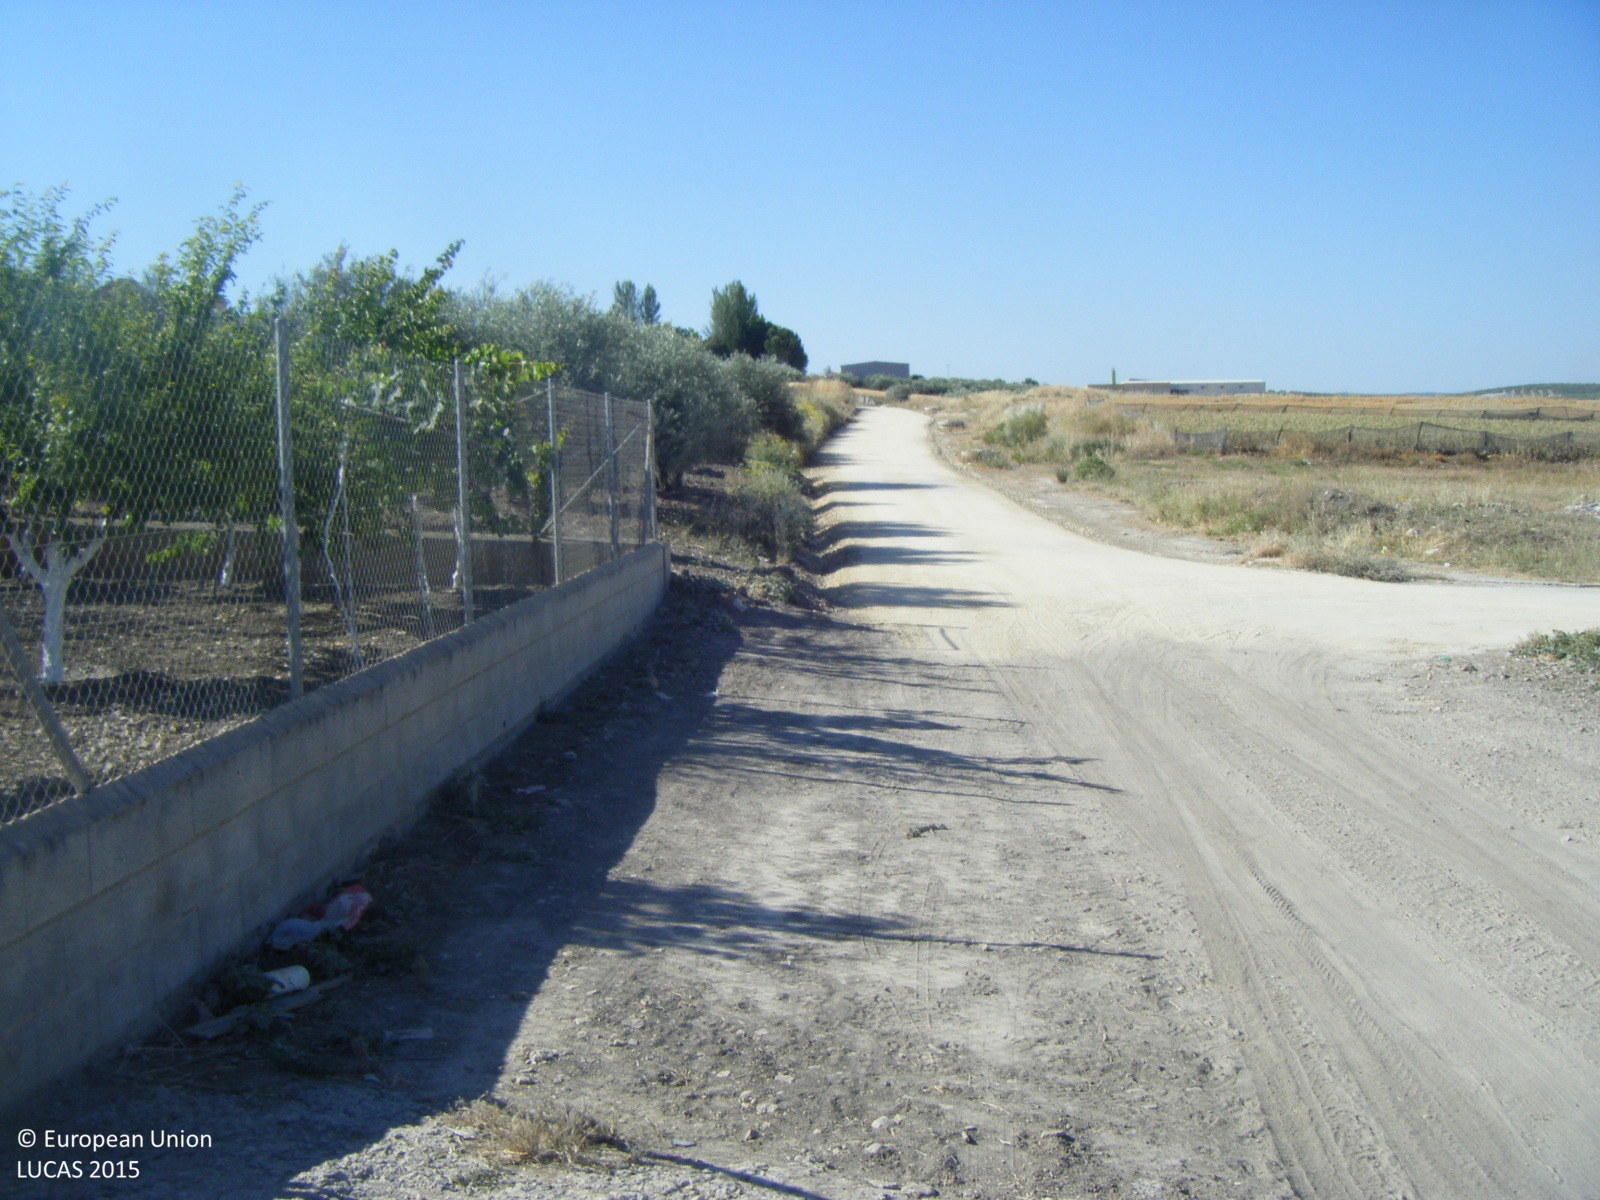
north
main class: Cropland
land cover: Olive groves
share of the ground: 10 - 25 %
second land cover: Other bare soil
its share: > 75 %
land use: Agriculture (excluding fallow land and kitchen gardens)
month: June
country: ES
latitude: 37.2678
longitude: -4.5364
